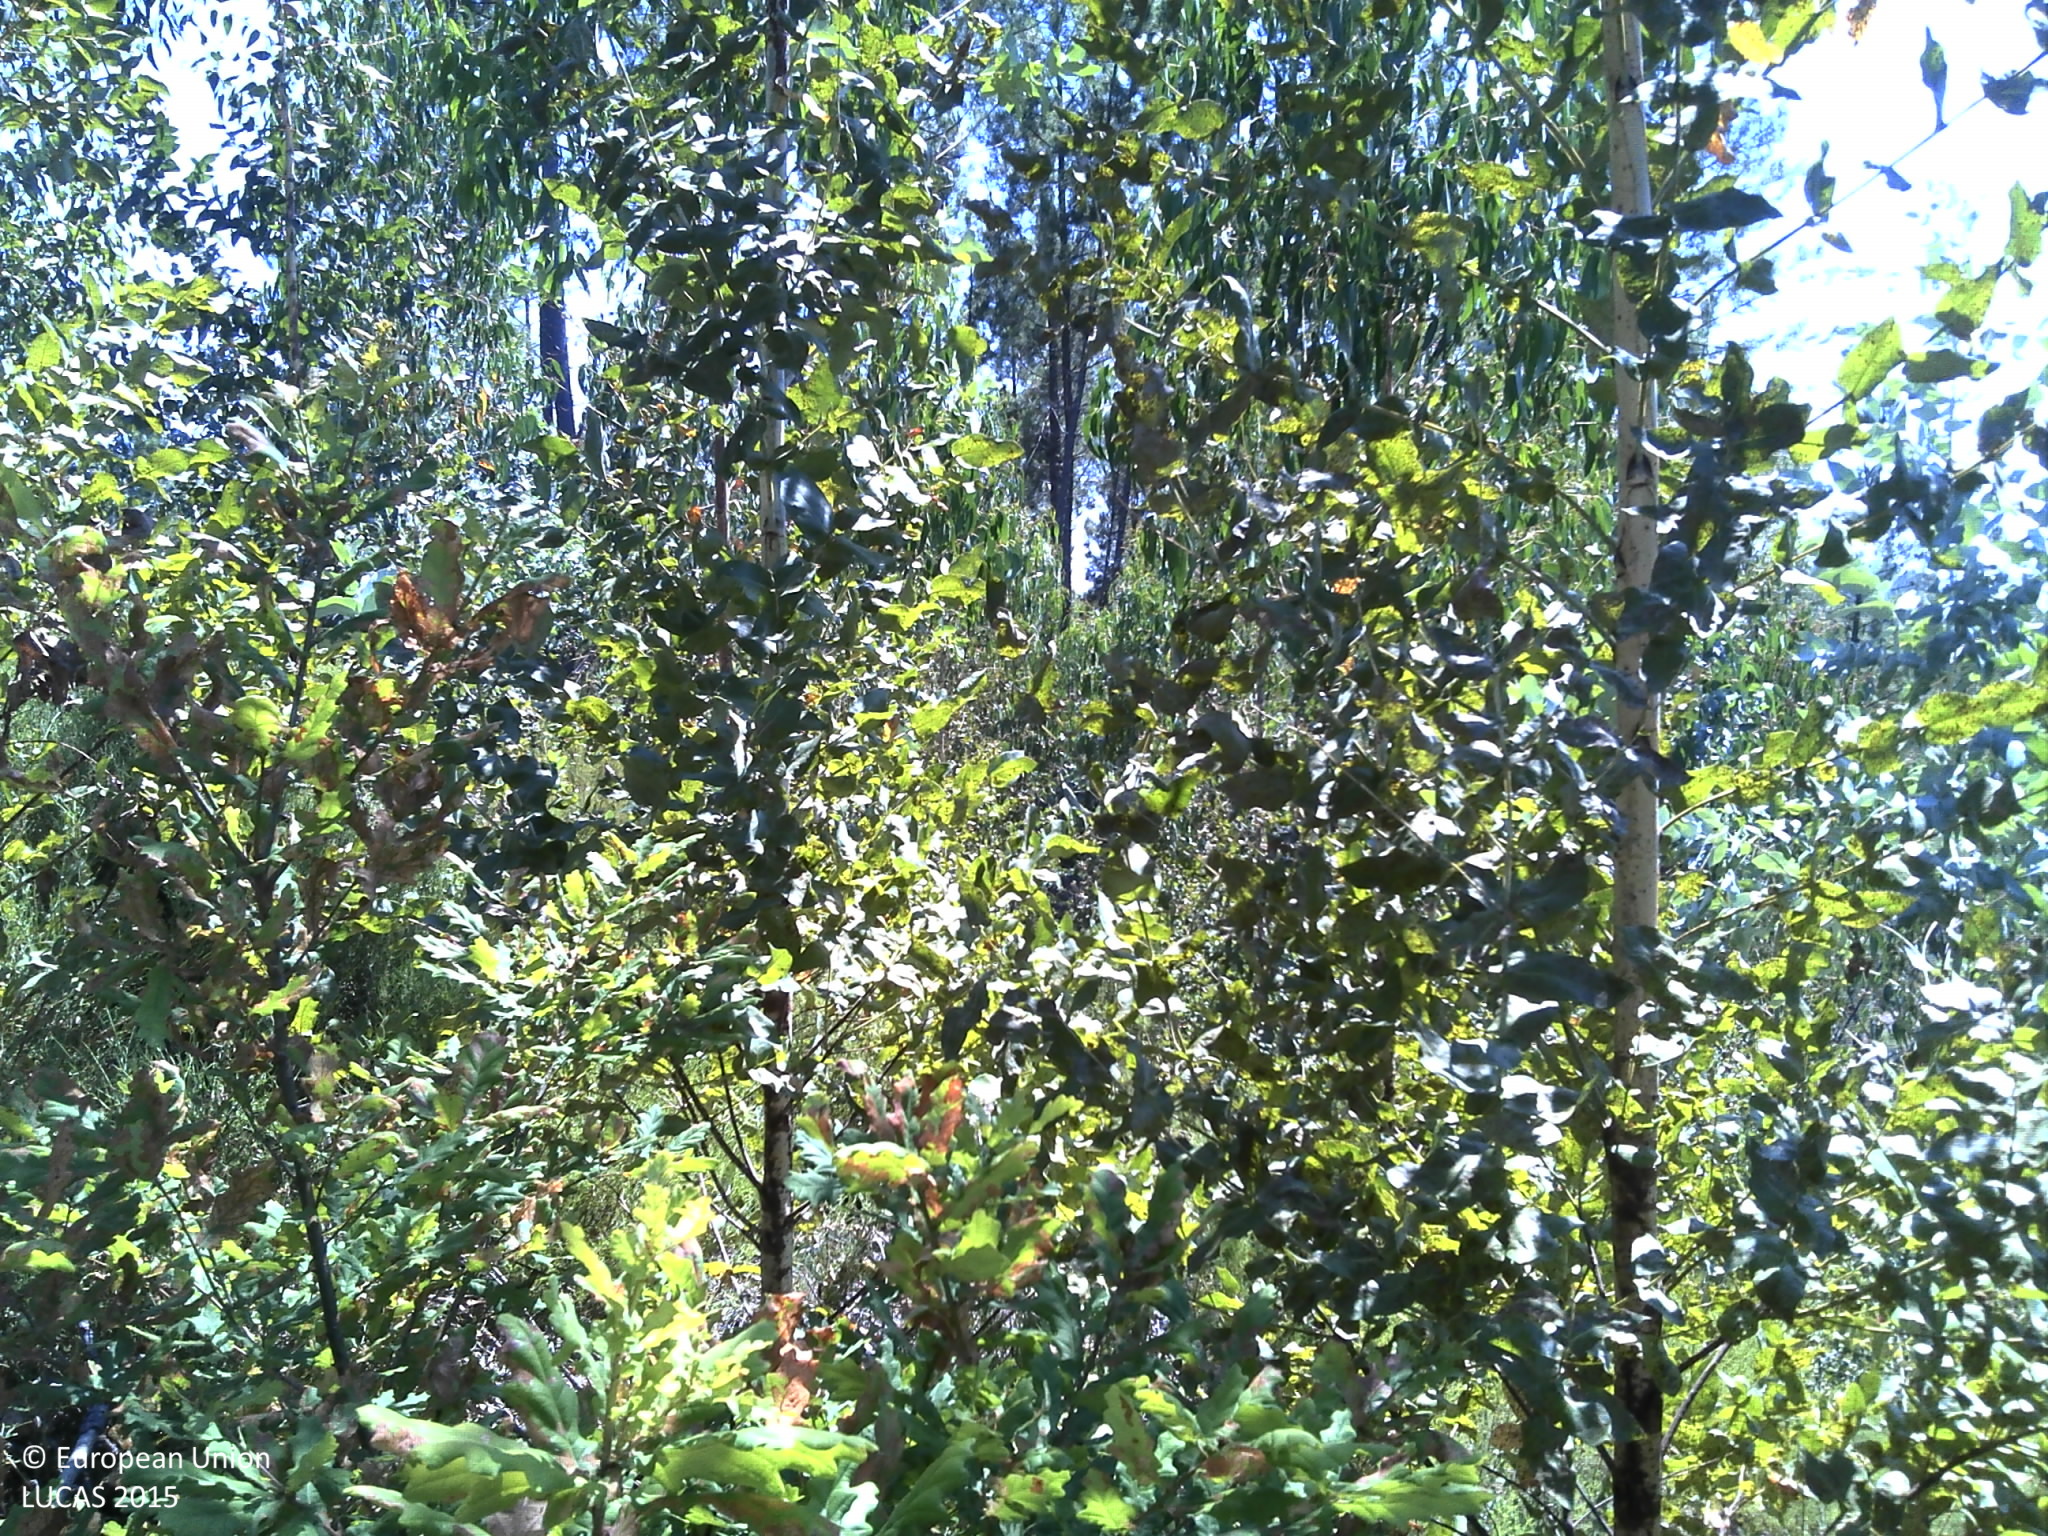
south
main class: Woodland
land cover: Broadleaved woodland
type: exotic forest
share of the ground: 10 - 25 %
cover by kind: unconsolidated bare surface 55 %, shrubs 30 %, broadleaved forest trees 15 %
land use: Forestry
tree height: > 5 m
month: July
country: PT
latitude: 39.9223
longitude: -8.1713
